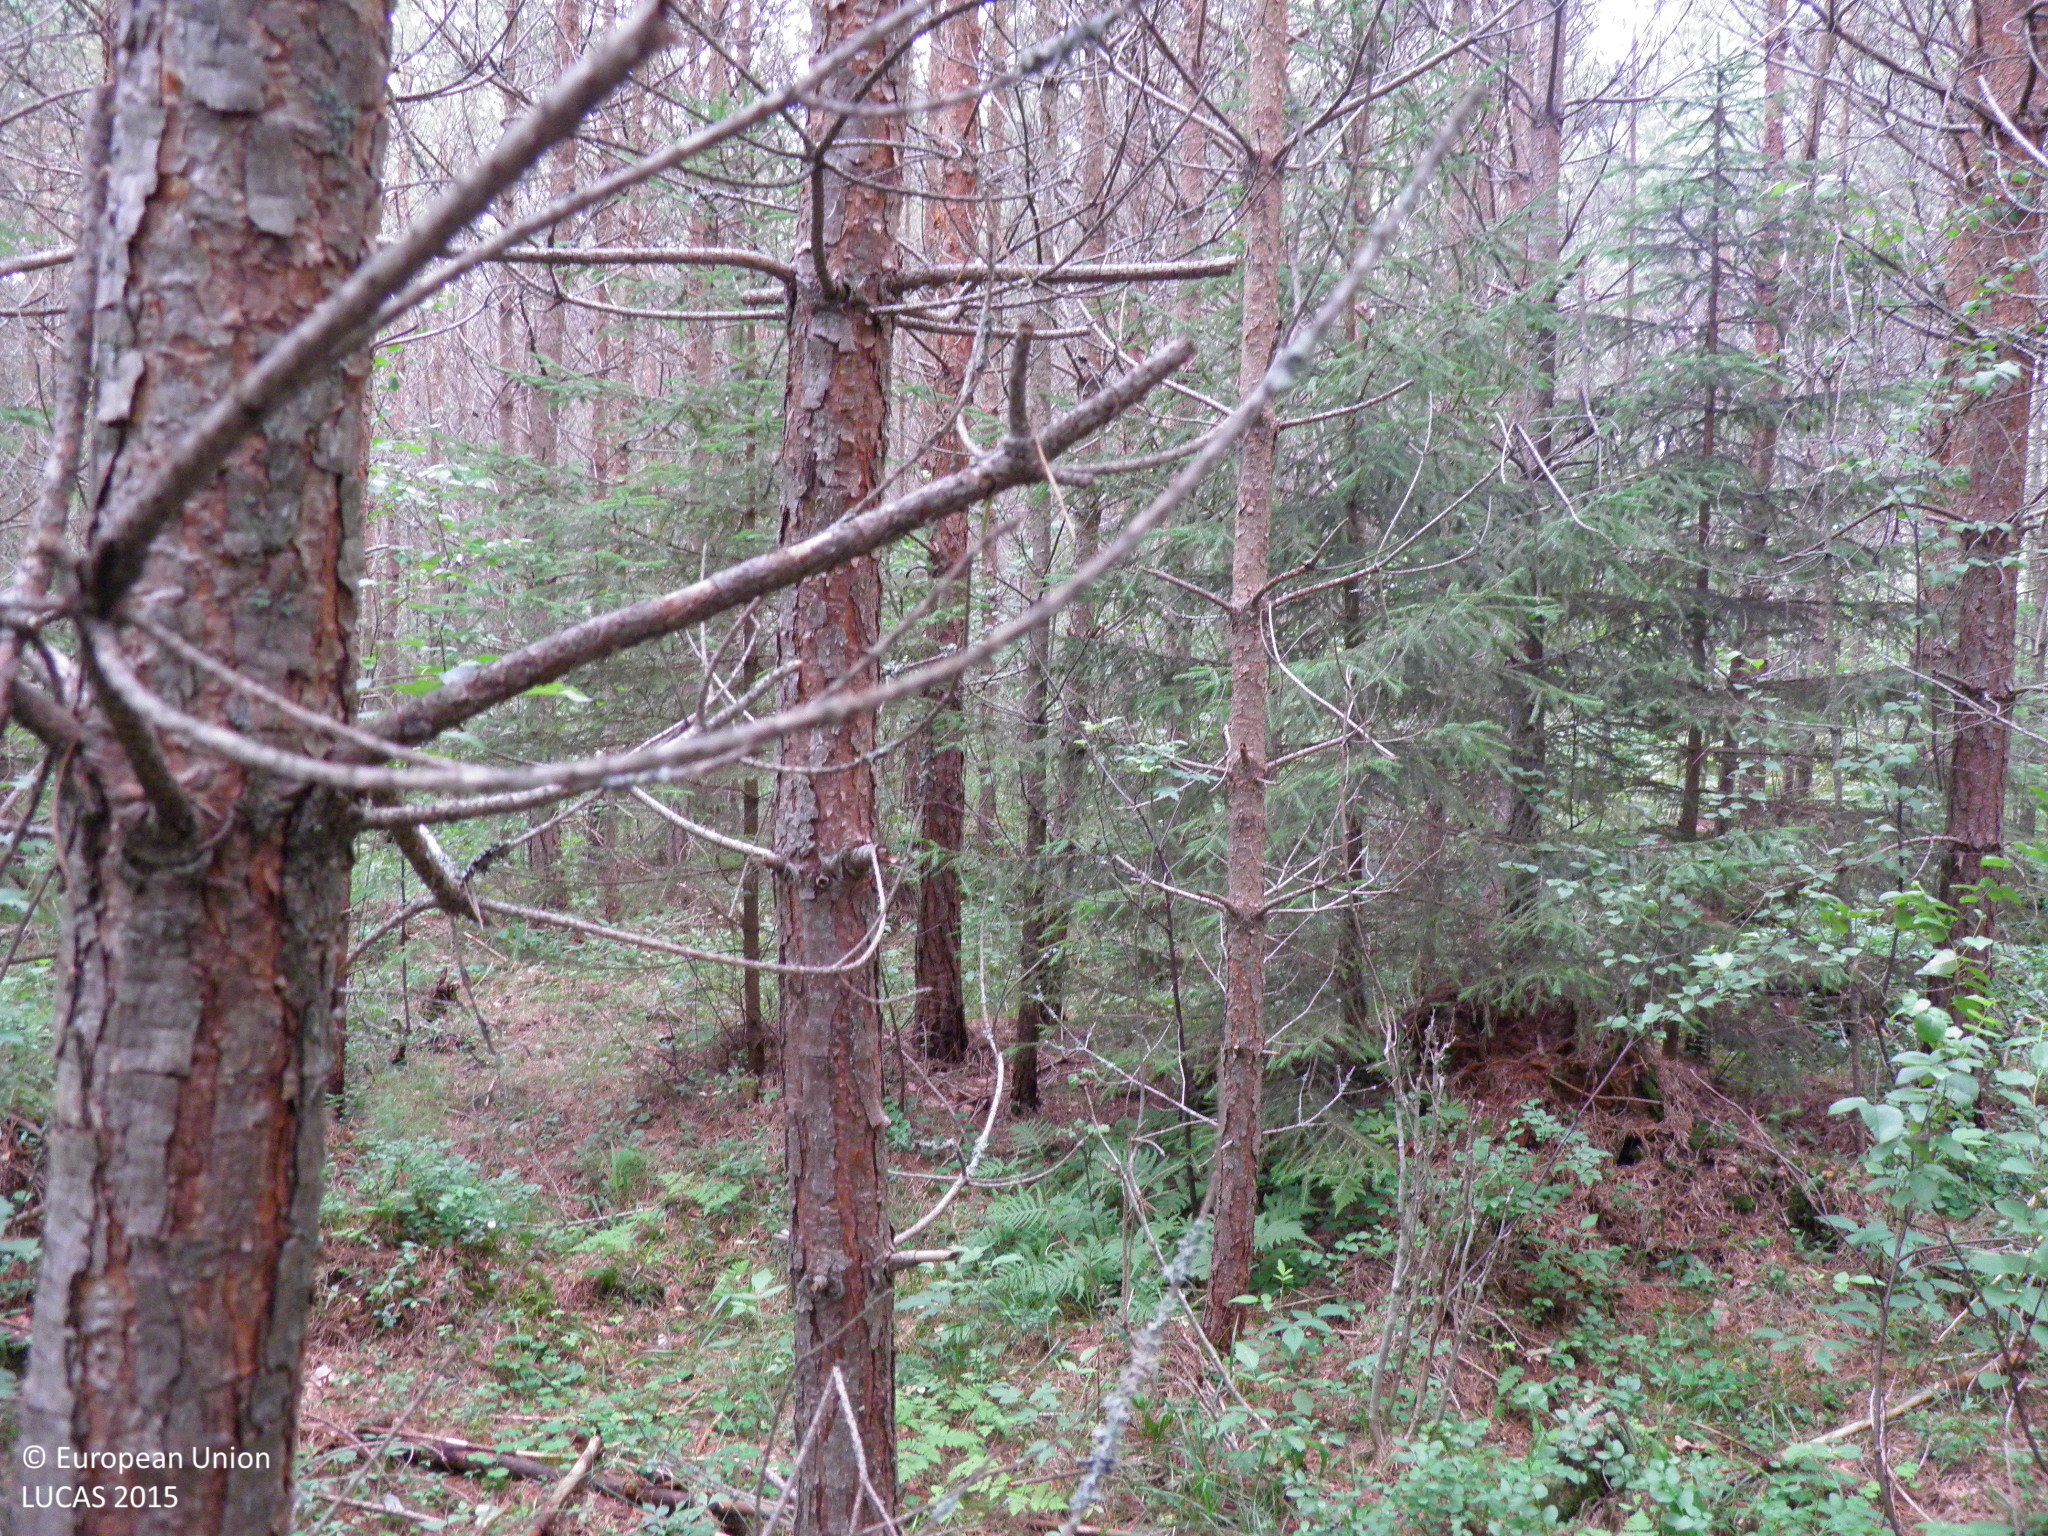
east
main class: Woodland
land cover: Pine dominated mixed woodland
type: hemiboreal forest and nemoral coniferous forest and mixed broadleaved-coniferous forest
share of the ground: > 75 %
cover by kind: coniferous forest trees 50 %, broadleaved forest trees 40 %, shrubs 5 %, herbaceous plants 5 %
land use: Forestry
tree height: > 5 m
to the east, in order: Pine dominated mixed woodland; Tracks; Pine dominated mixed woodland
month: July
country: FI
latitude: 60.1804
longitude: 22.7867
